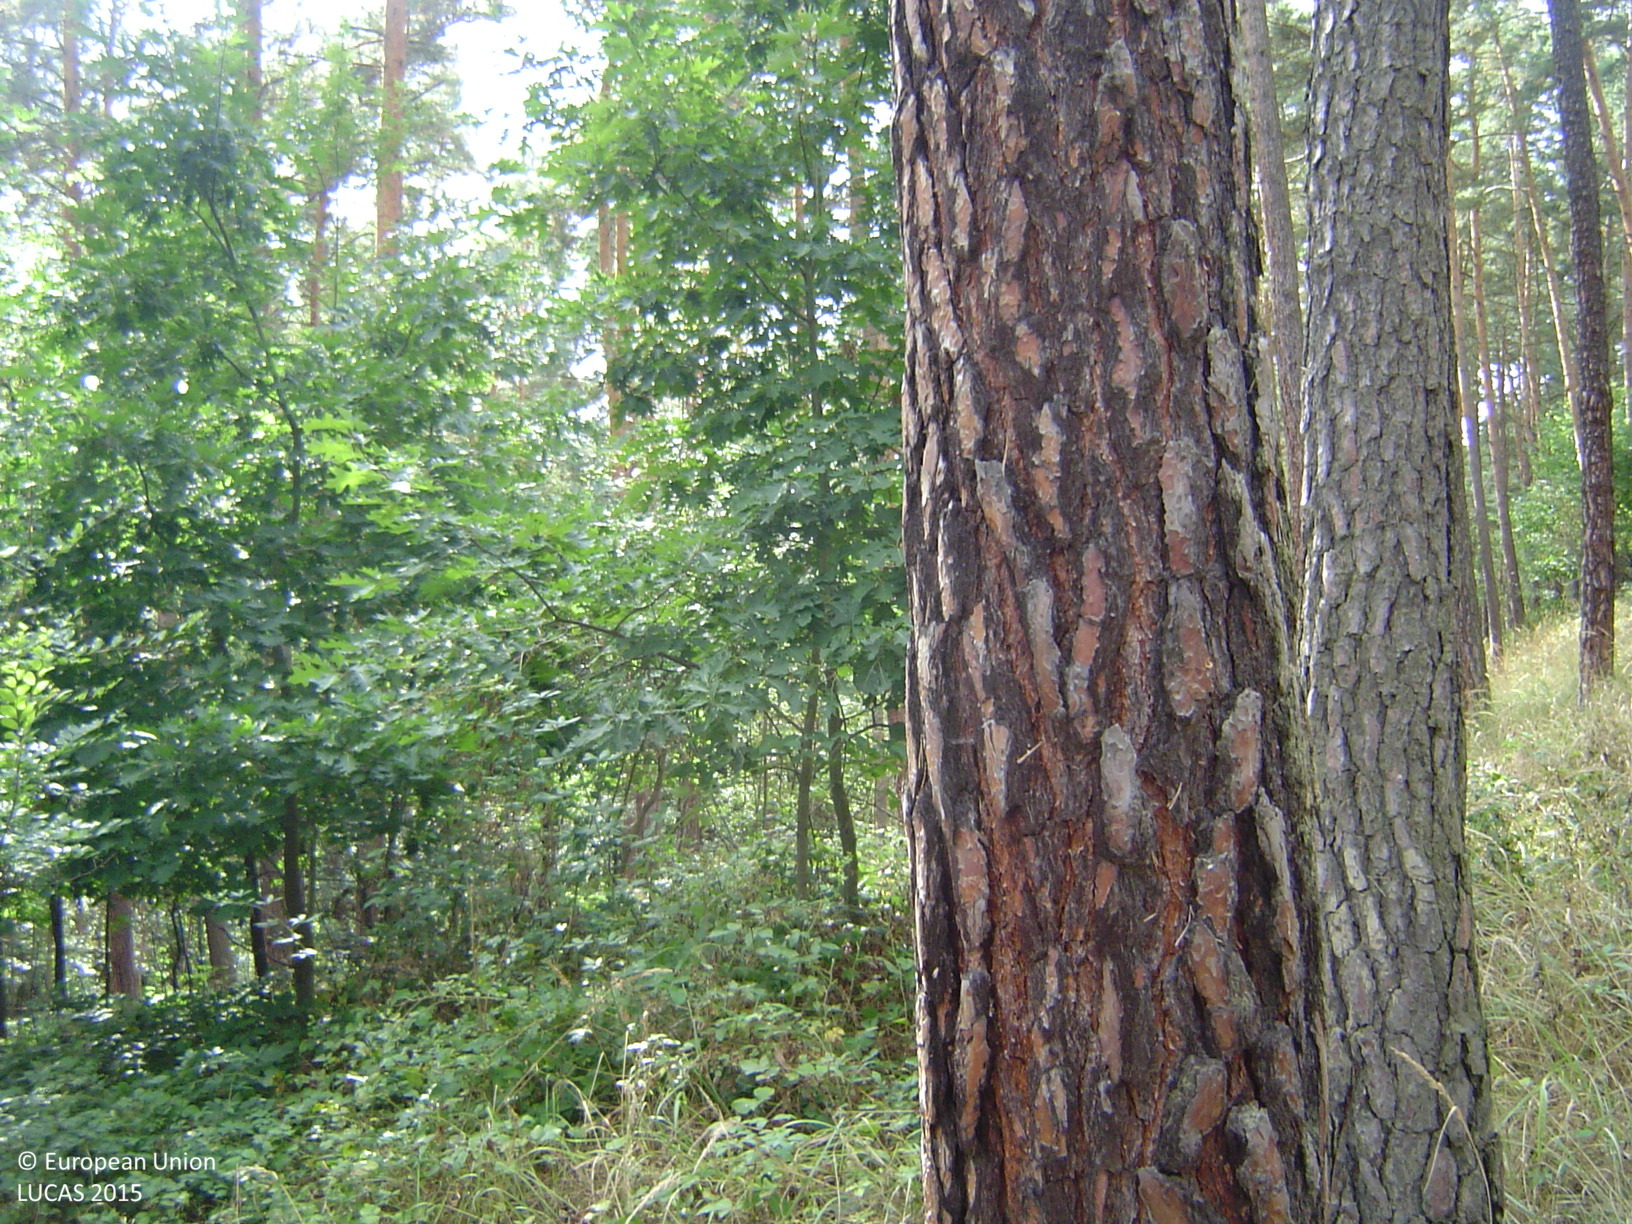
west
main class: Woodland
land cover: Pine dominated coniferous woodland
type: hemiboreal forest and nemoral coniferous forest and mixed broadleaved-coniferous forest
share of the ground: > 75 %
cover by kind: coniferous forest trees 85 %, broadleaved forest trees 10 %, herbaceous plants 5 %
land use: Forestry
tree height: > 5 m
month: August
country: CZ
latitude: 49.7424
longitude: 14.3170
